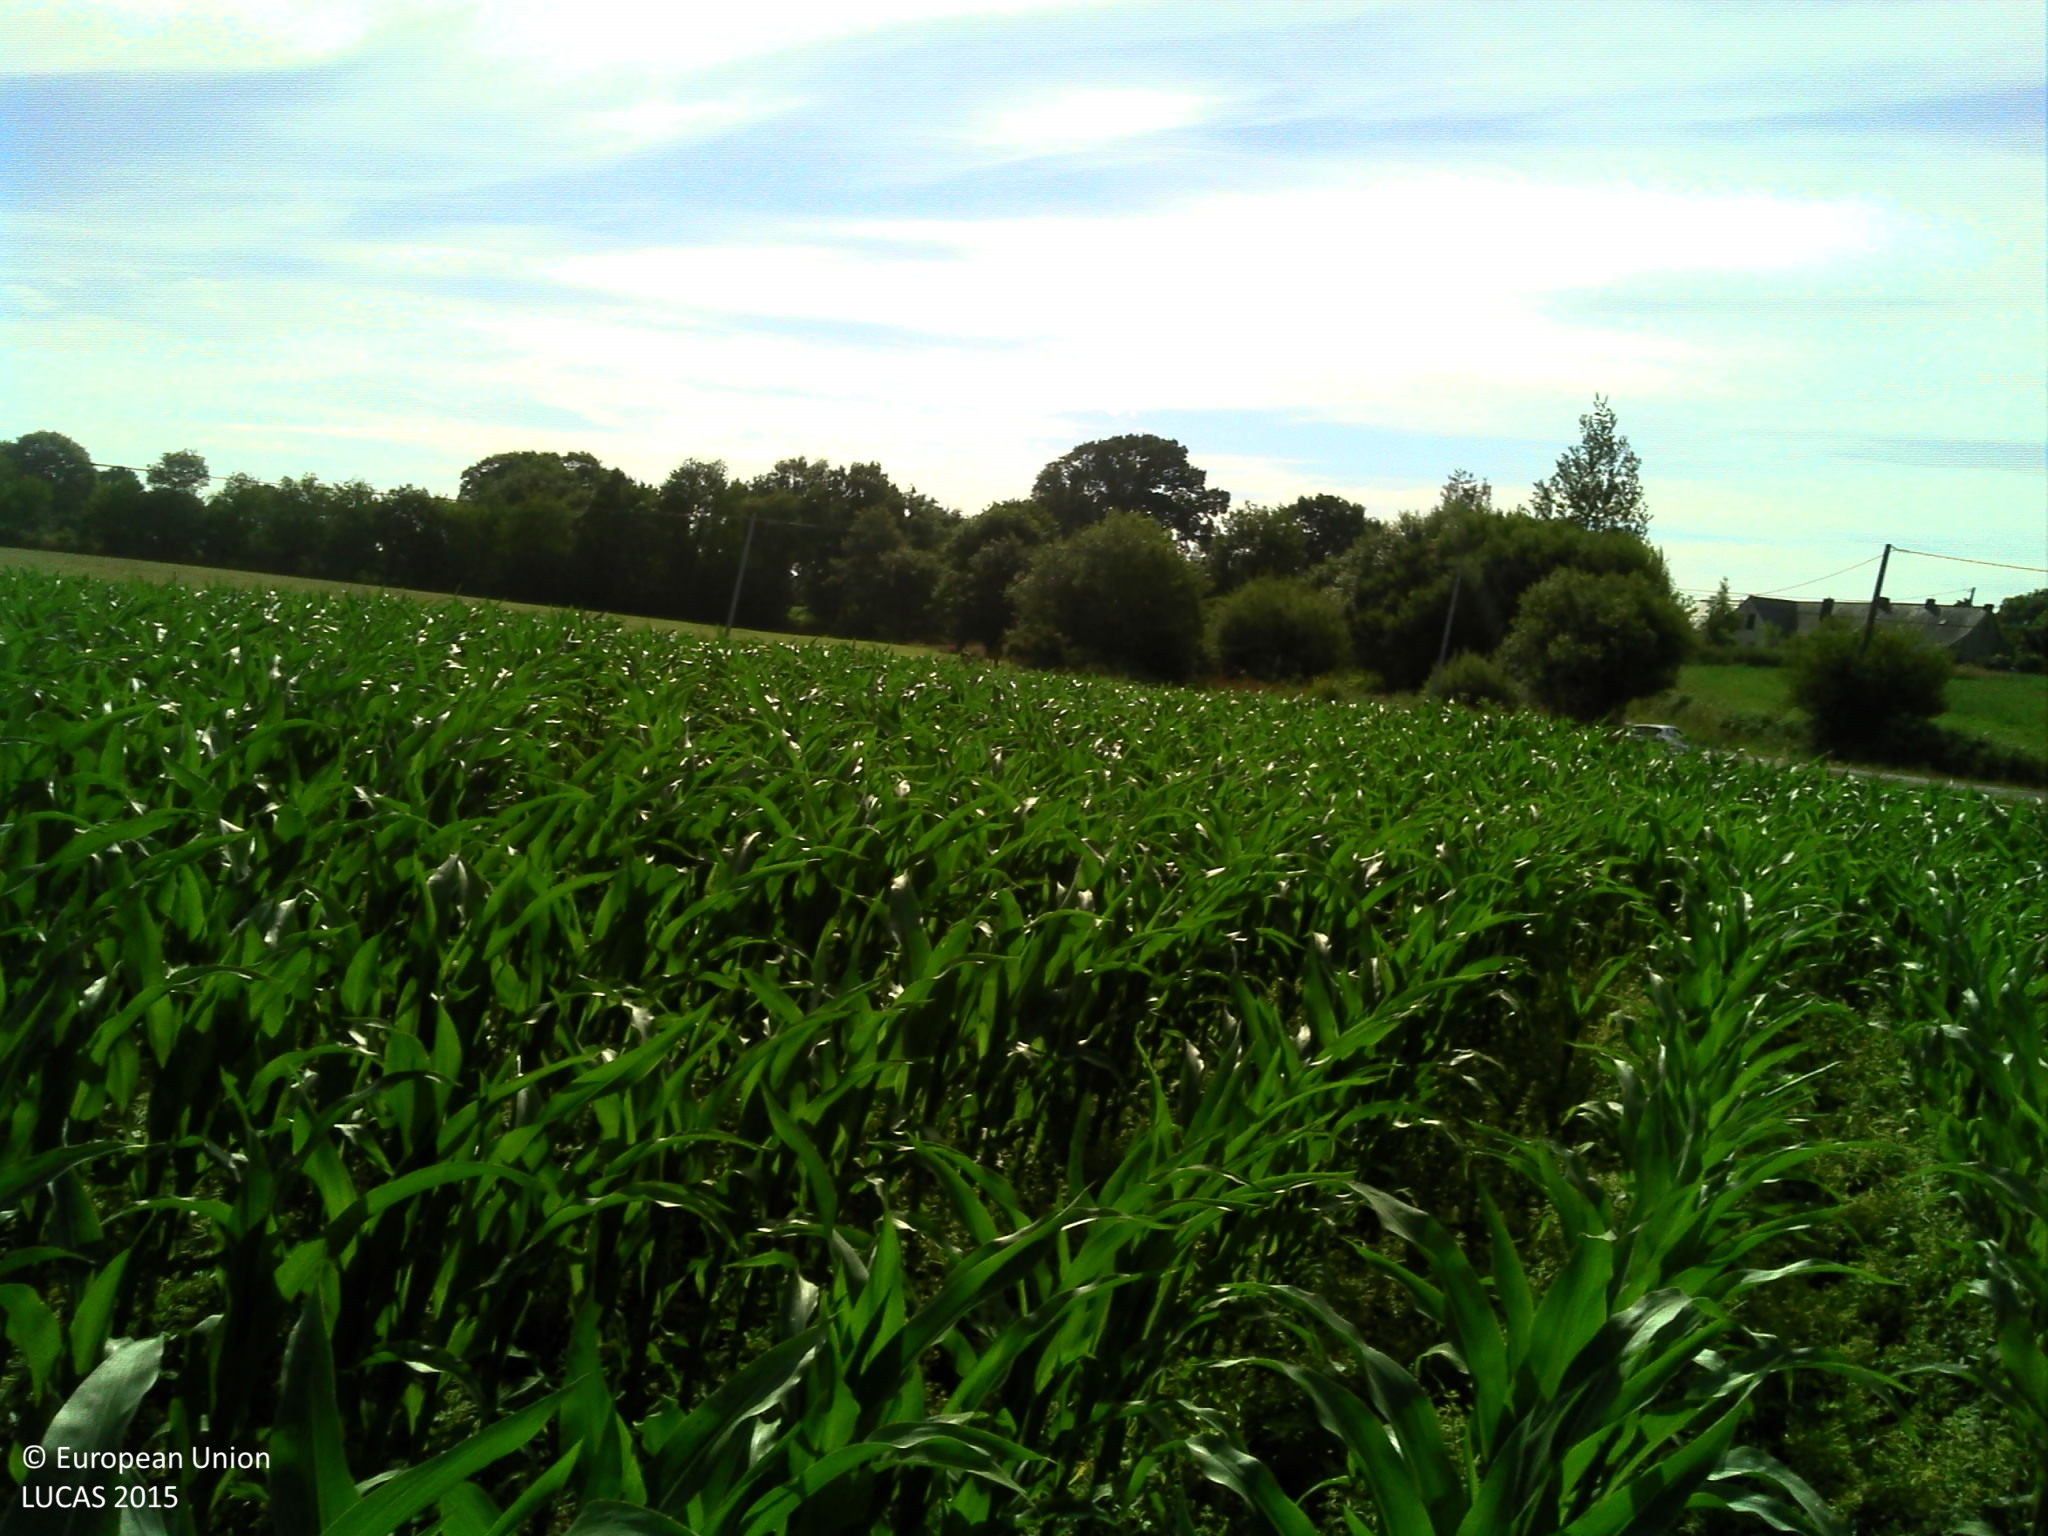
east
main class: Cropland
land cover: Maize
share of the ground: > 75 %
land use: Agriculture (excluding fallow land and kitchen gardens)
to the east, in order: Maize; Abandoned hedges; Ditches and canals; Grass margins; Paved roads, cycling and walking lanes; Grass margins; Ditches and canals; Electric lines; Abandoned hedges; Grassland without tree/shrub cover; Abandoned hedges; Maize
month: June
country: FR
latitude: 47.9612
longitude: -2.0388
